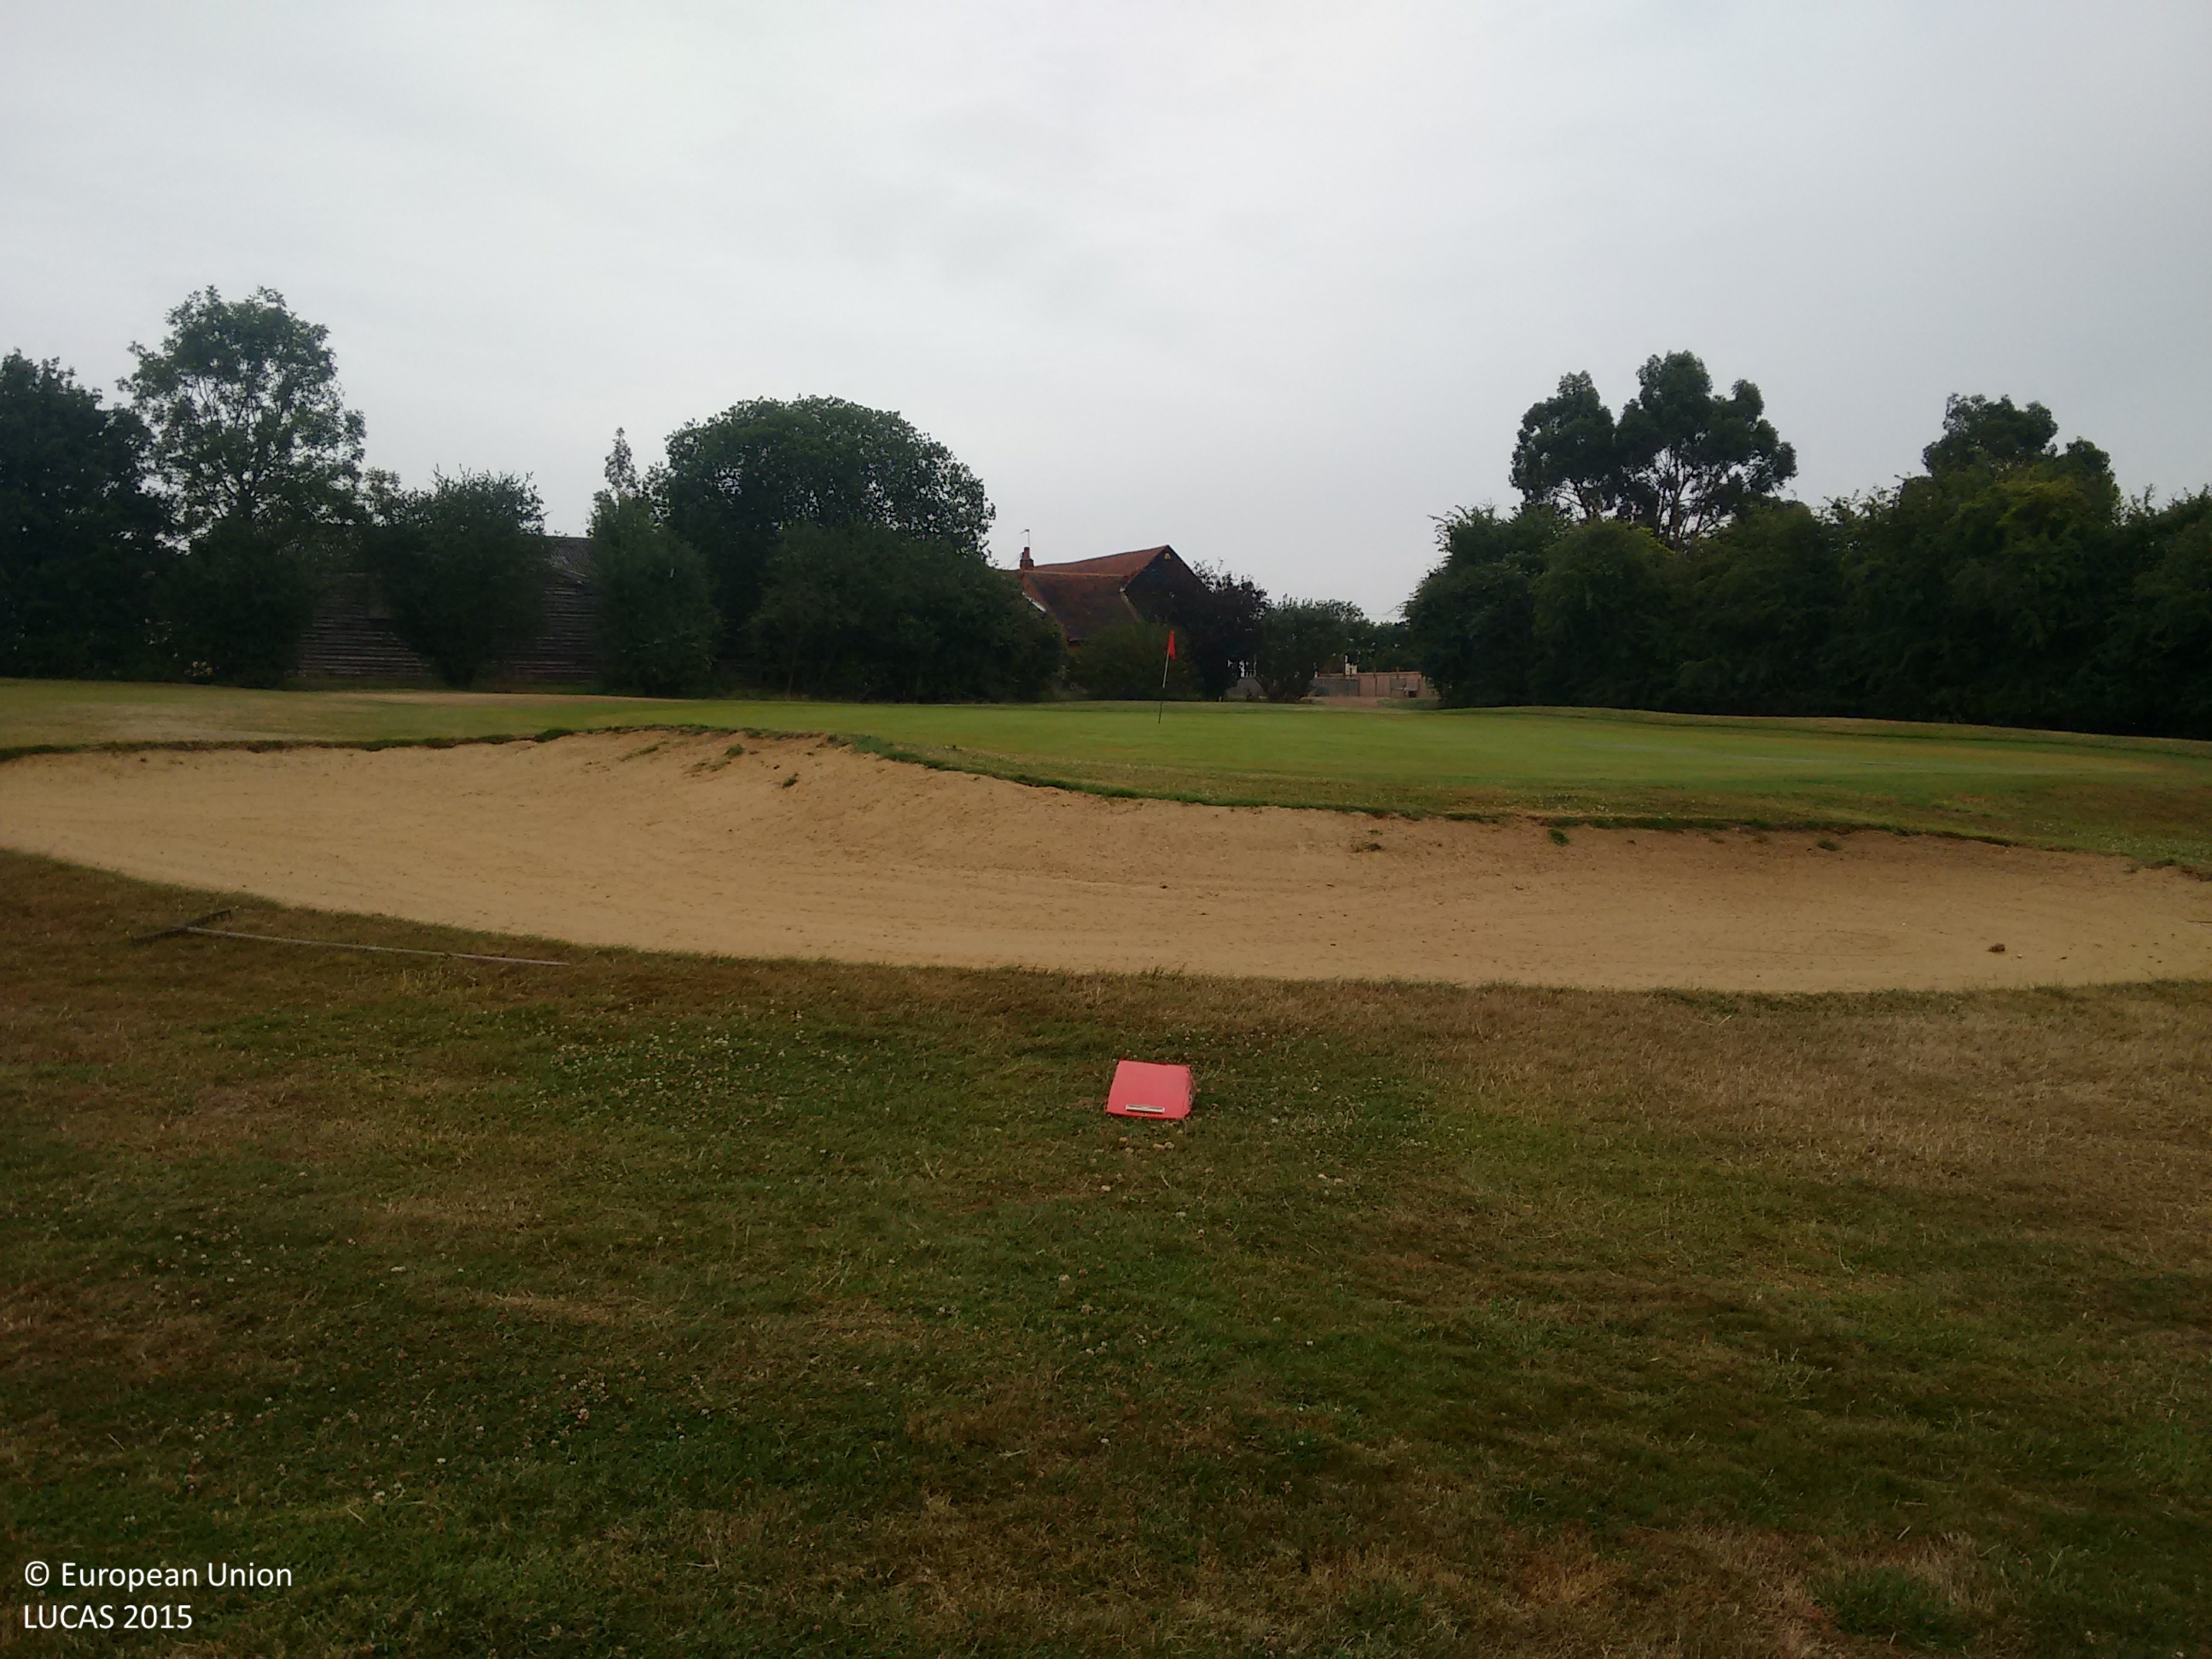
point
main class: Grassland
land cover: Grassland without tree/shrub cover
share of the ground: > 75 %
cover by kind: herbaceous plants 100 %
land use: Sport
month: July
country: GB
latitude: 51.7326
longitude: 0.6049
